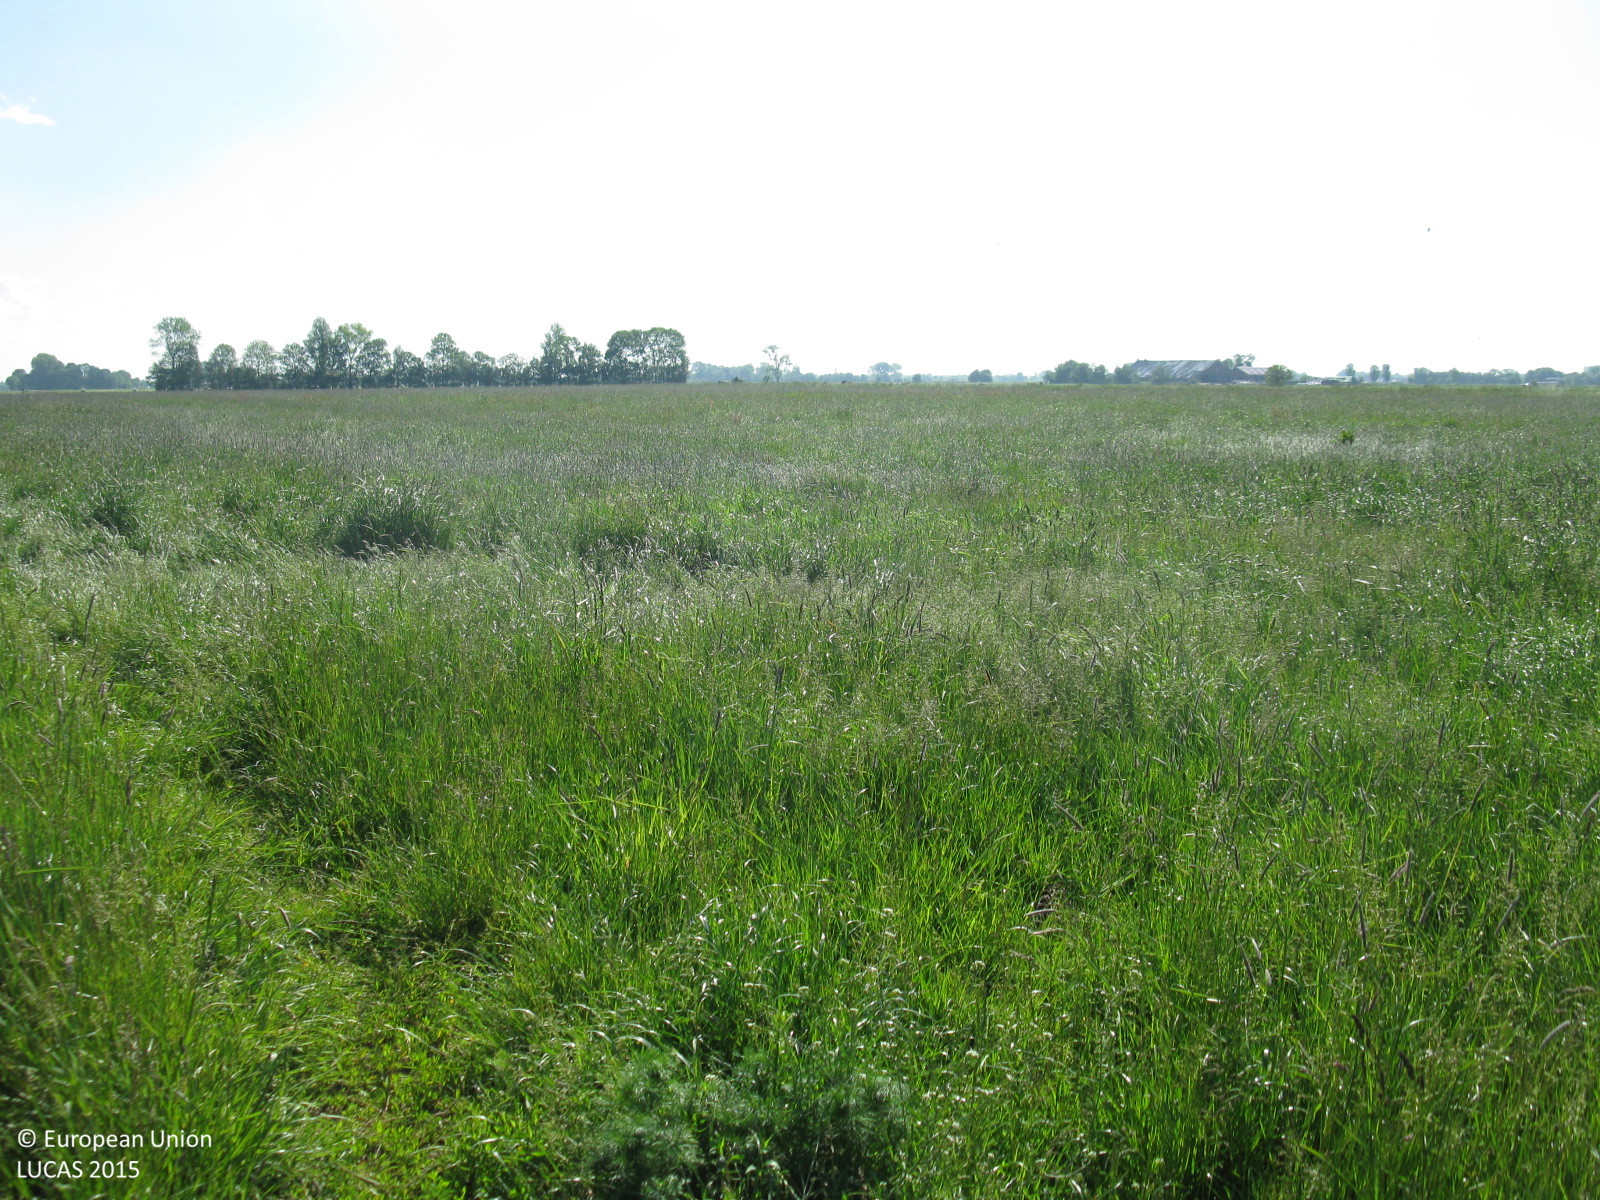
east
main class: Grassland
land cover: Grassland without tree/shrub cover
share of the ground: > 75 %
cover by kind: herbaceous plants 100 %
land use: Agriculture (excluding fallow land and kitchen gardens)
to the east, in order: Grassland without tree/shrub cover; Fences; Ditches and canals; Grassland without tree/shrub cover; Ditches and canals; Grass margins; Tracks; Grass margins; Ditches and canals; Grassland without tree/shrub cover
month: June
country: DE
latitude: 53.2471
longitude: 7.3480
